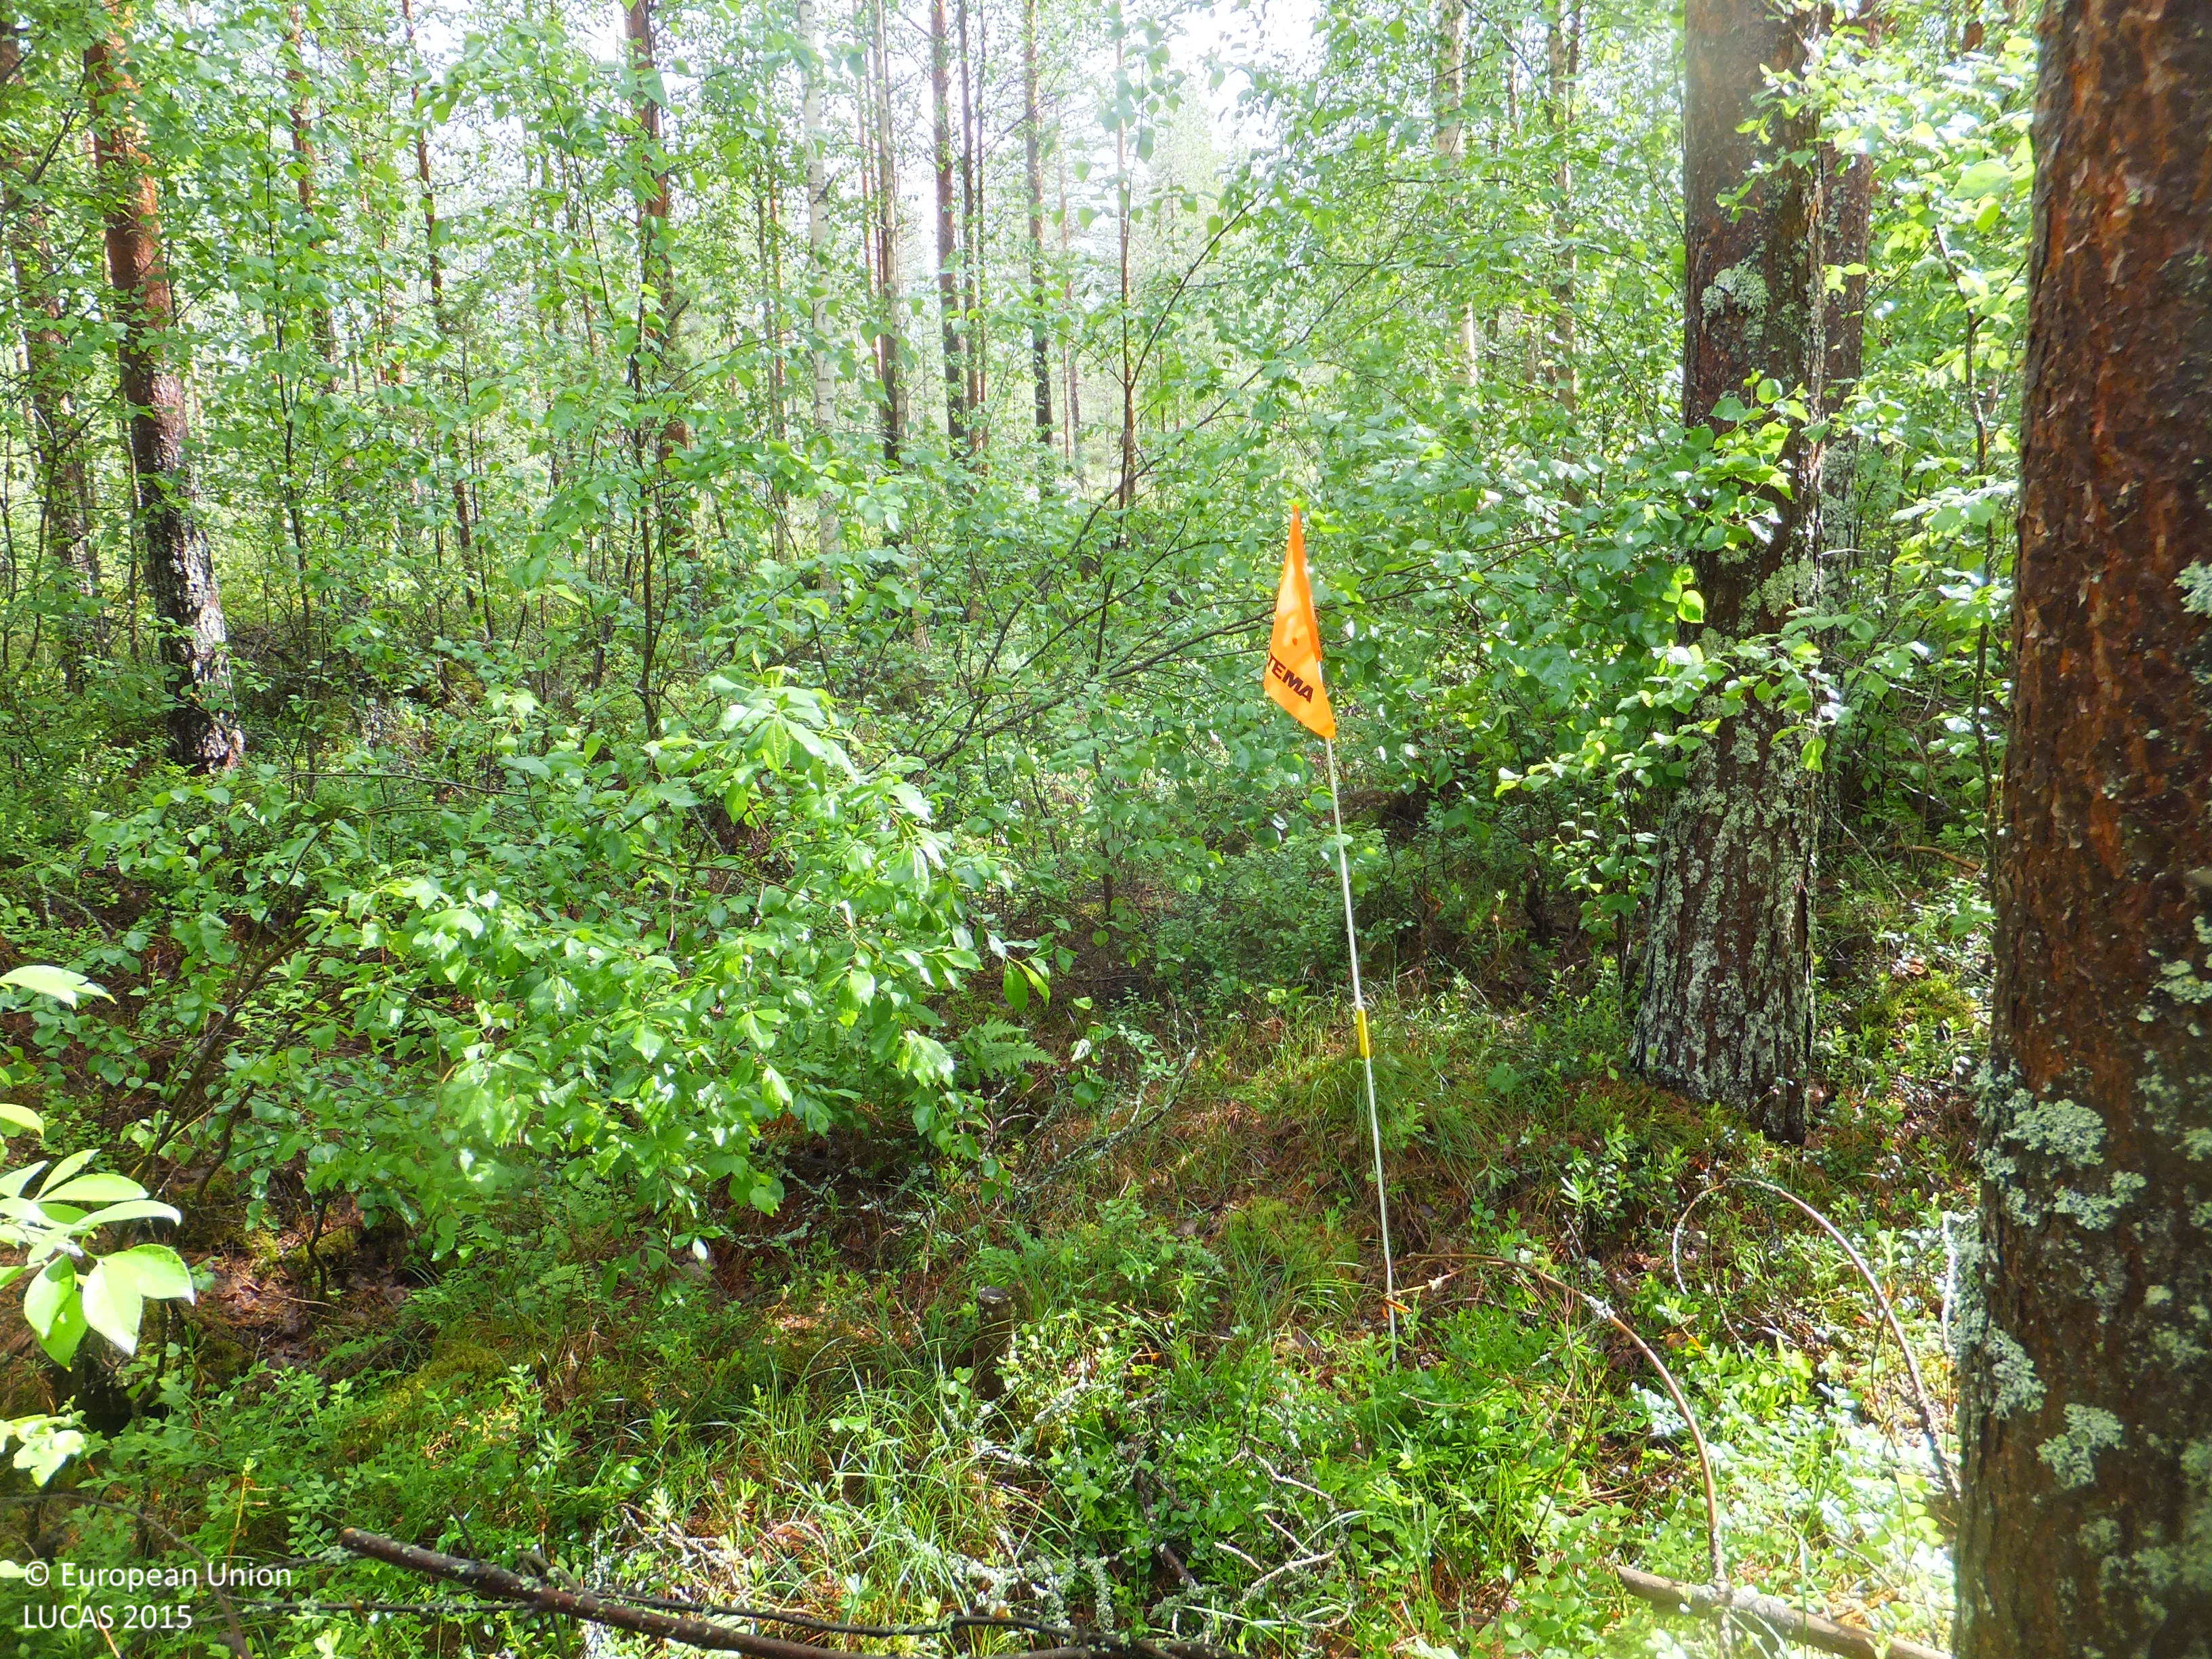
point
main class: Woodland
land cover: Pine dominated mixed woodland
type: boreal forest
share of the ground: > 75 %
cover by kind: coniferous forest trees 45 %, broadleaved forest trees 35 %, herbaceous plants 10 %, shrubs 5 %, lichens and mosses 5 %
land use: Forestry
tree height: > 5 m
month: June
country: FI
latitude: 63.4212
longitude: 24.8111
